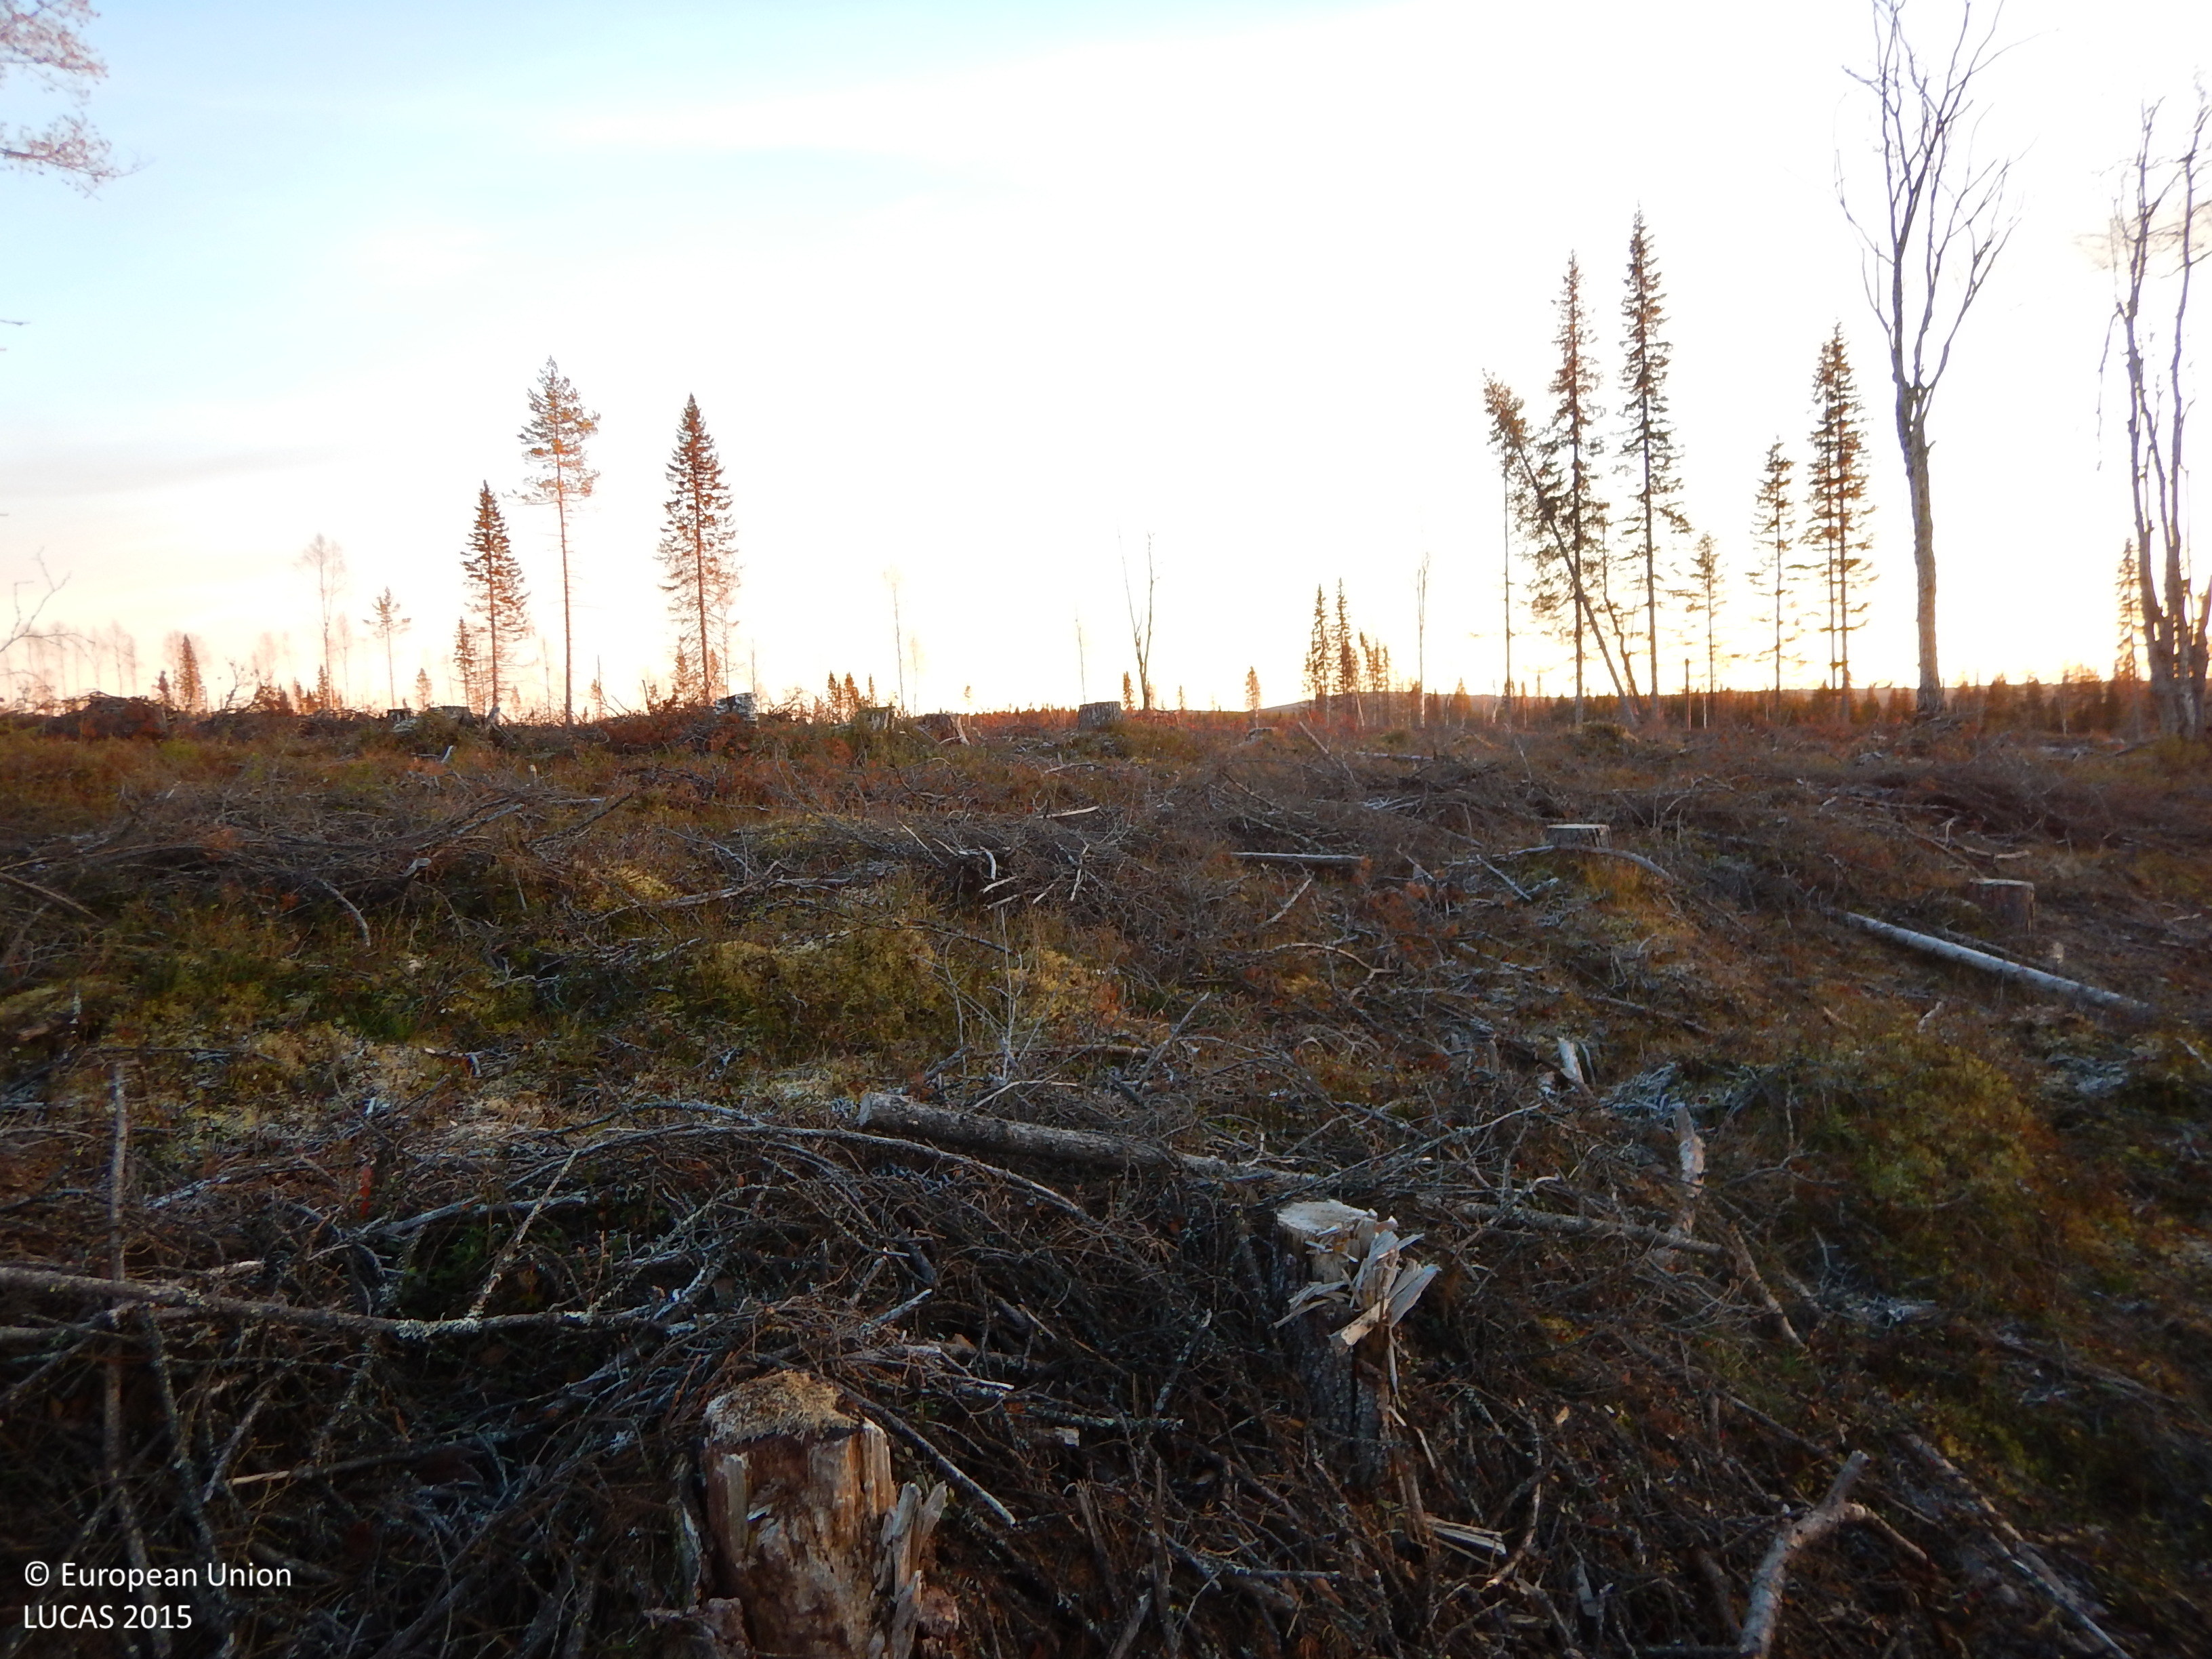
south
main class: Shrubland
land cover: Shrubland with sparse tree cover
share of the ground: 25 - 50 %
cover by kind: shrubs 40 %, herbaceous plants 25 %, lichens and mosses 20 %, coniferous forest trees 5 %
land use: Forestry
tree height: > 5 m
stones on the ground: < 10 %
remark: Clear cut
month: November
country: SE
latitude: 65.2115
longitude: 20.5944
